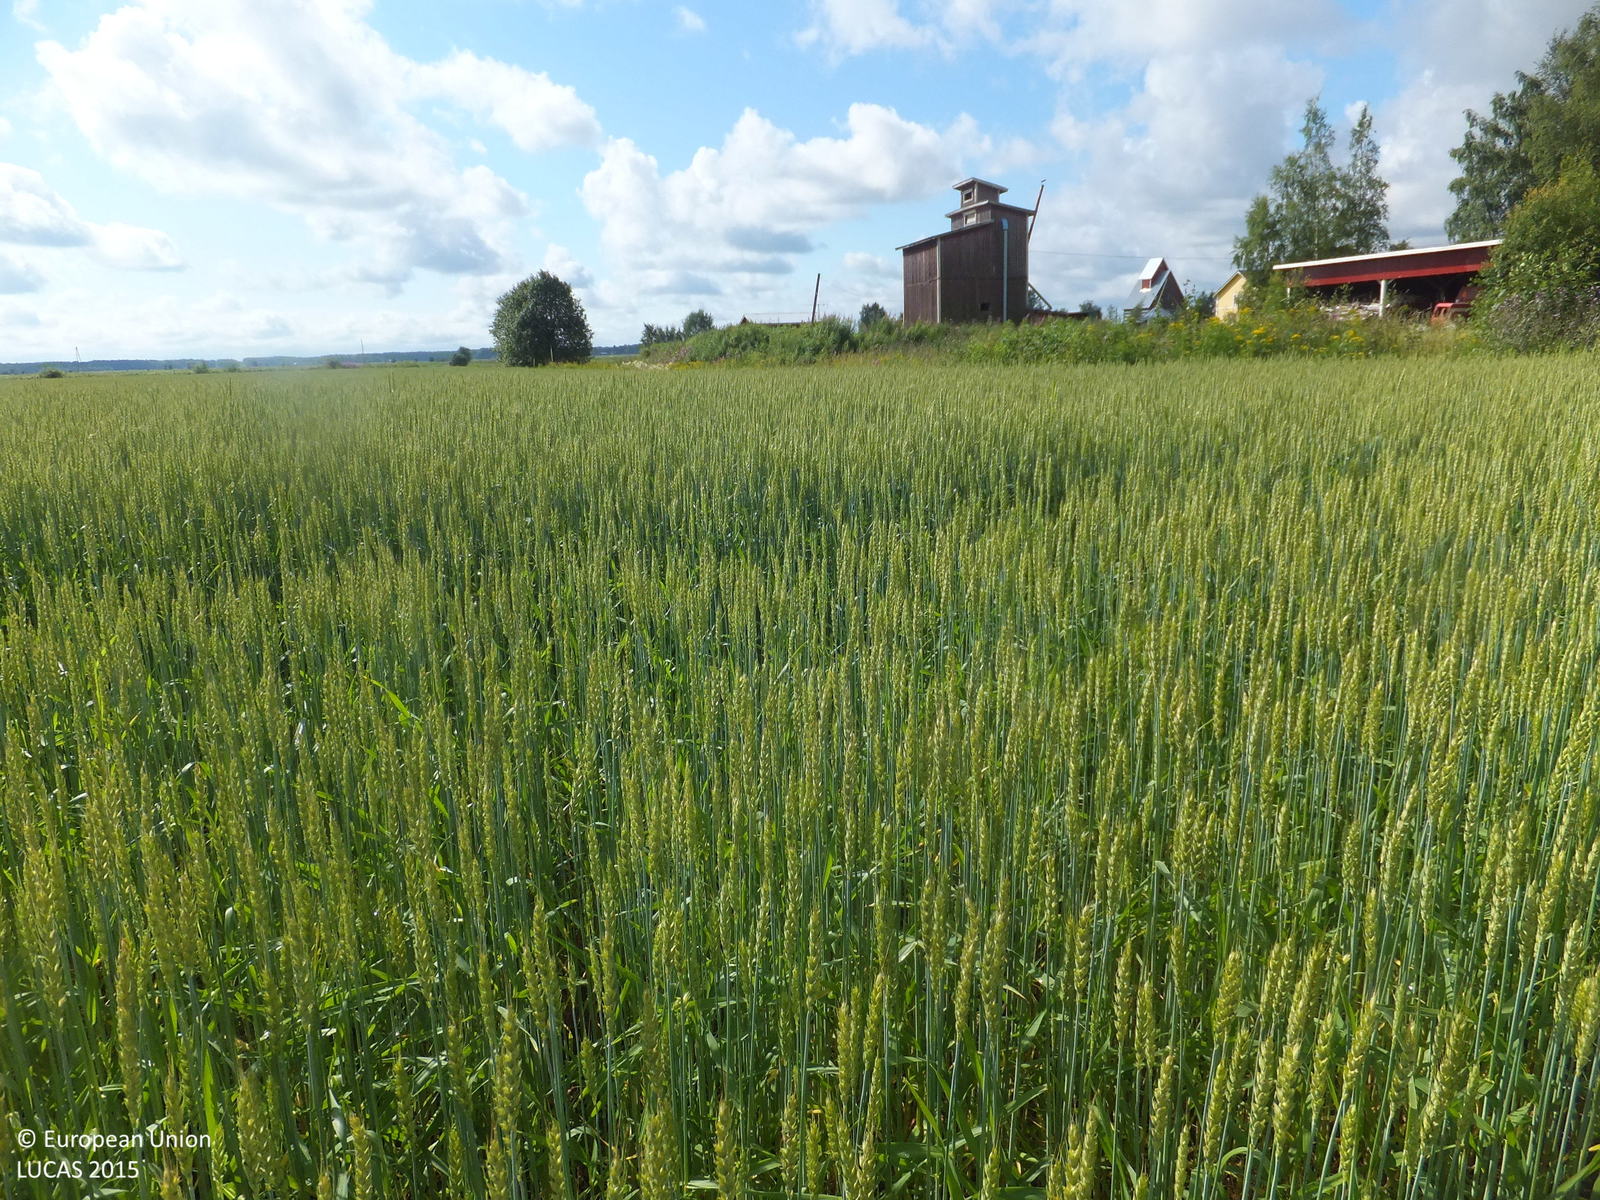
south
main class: Cropland
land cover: Common wheat
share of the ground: > 75 %
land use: Agriculture (excluding fallow land and kitchen gardens)
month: July
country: FI
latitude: 63.0702
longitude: 22.1387
